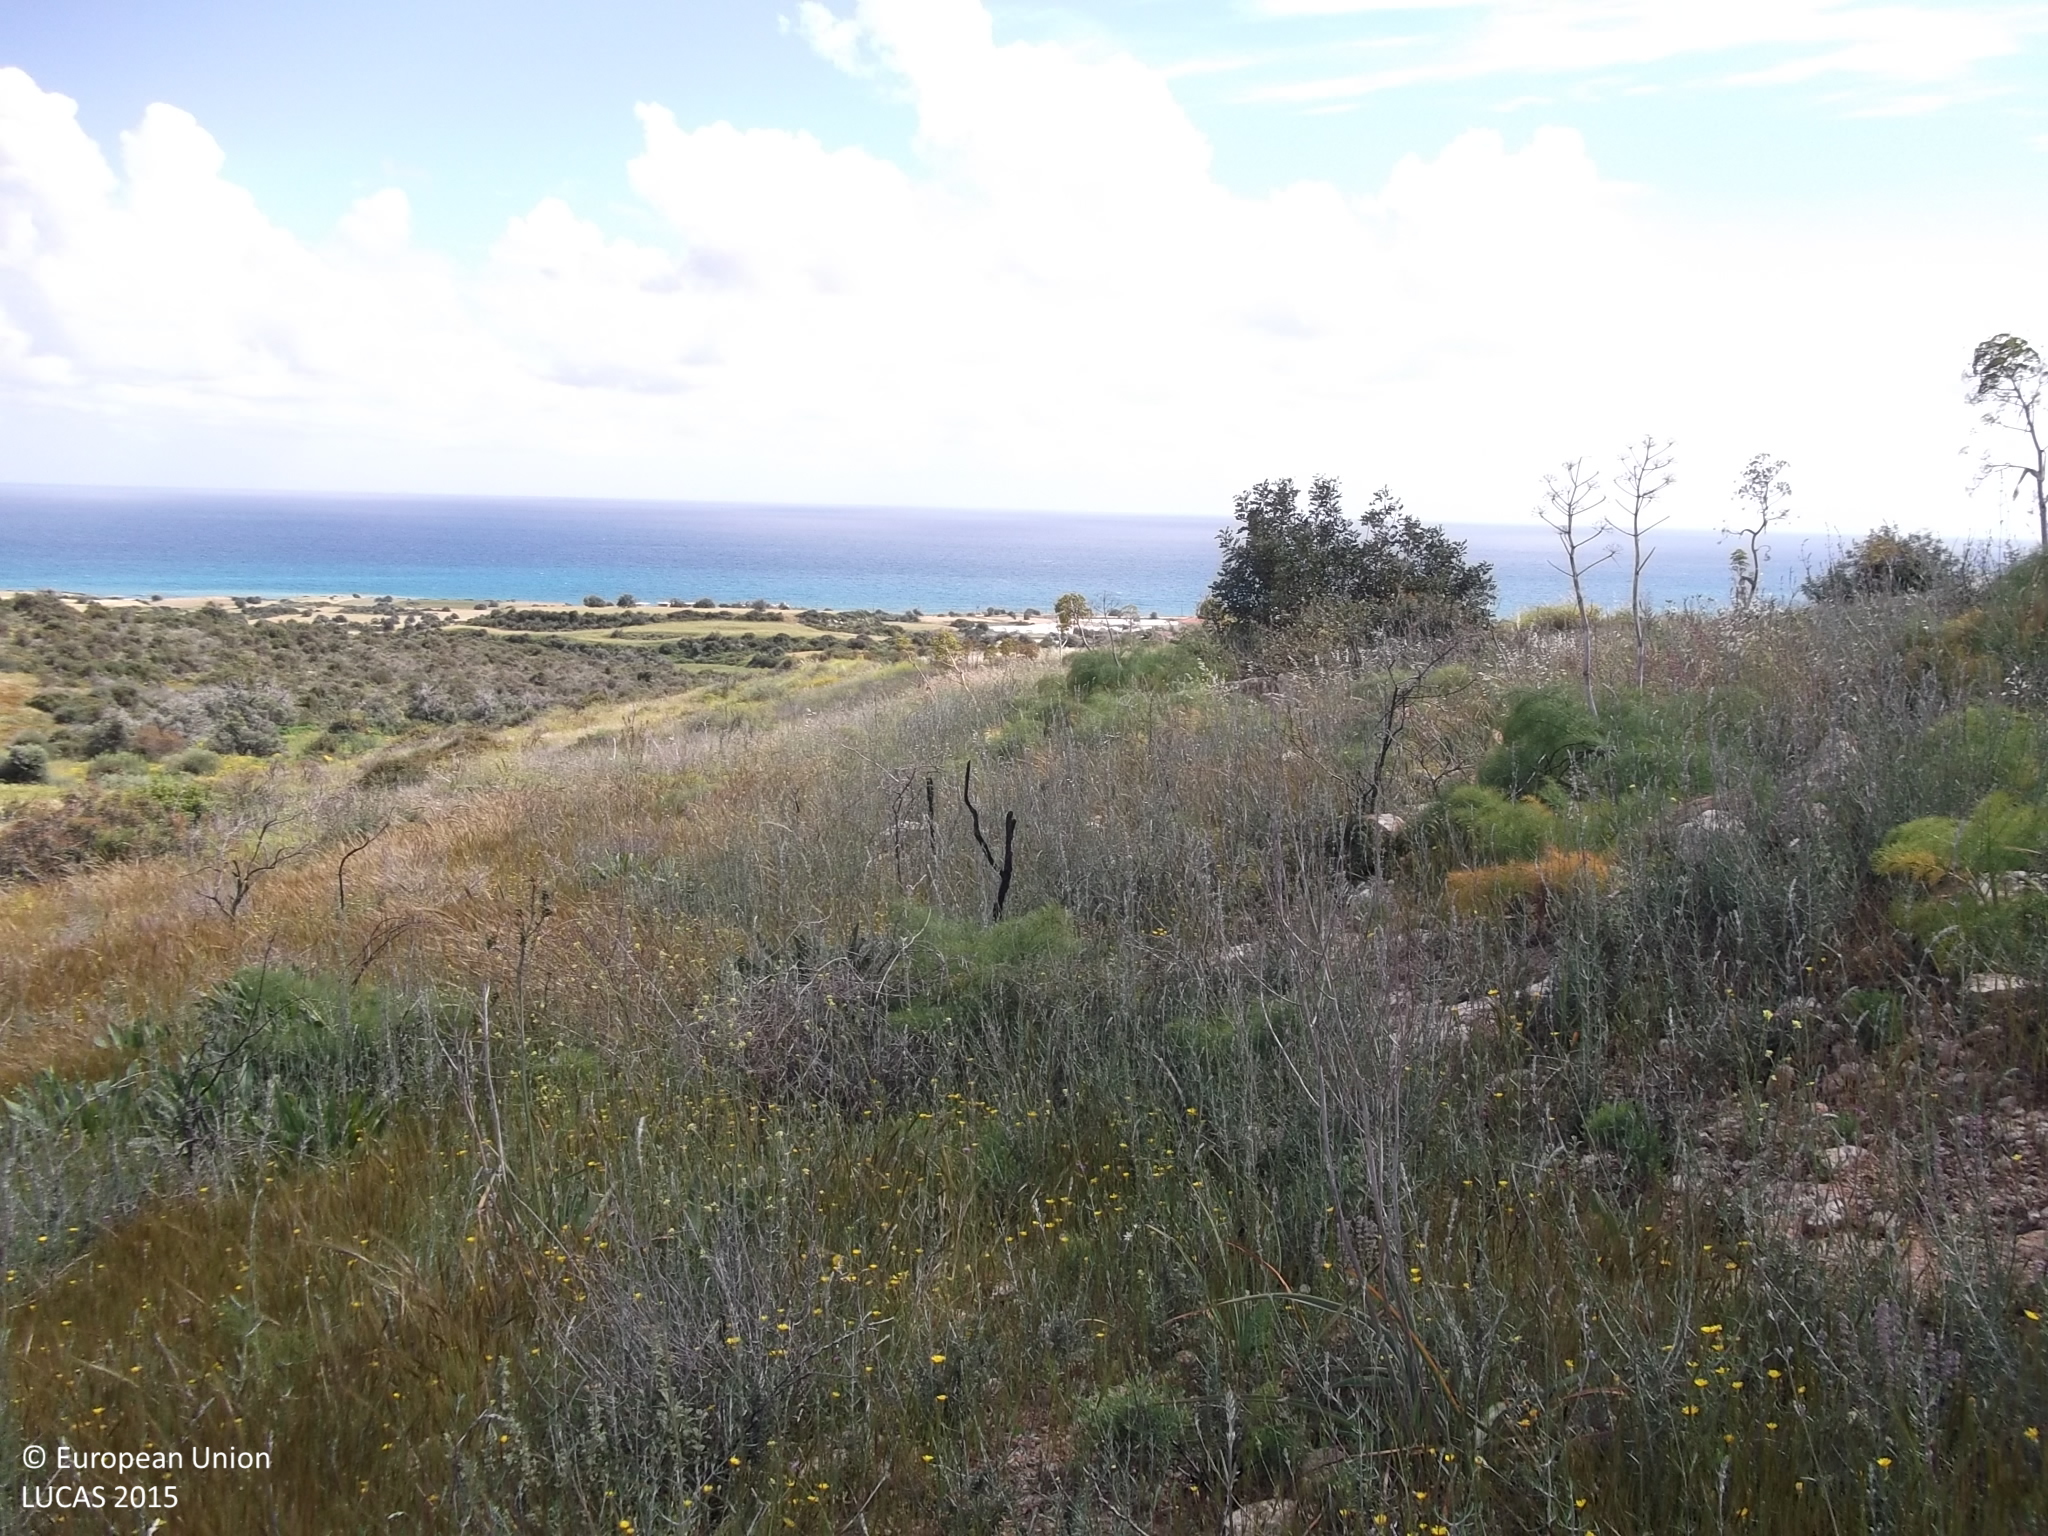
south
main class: Shrubland
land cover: Shrubland without tree cover
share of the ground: 50 - 75 %
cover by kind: shrubs 70 %, herbaceous plants 30 %
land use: Semi-natural and natural areas not in use
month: April
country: CY
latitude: 34.7779
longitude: 33.4256
